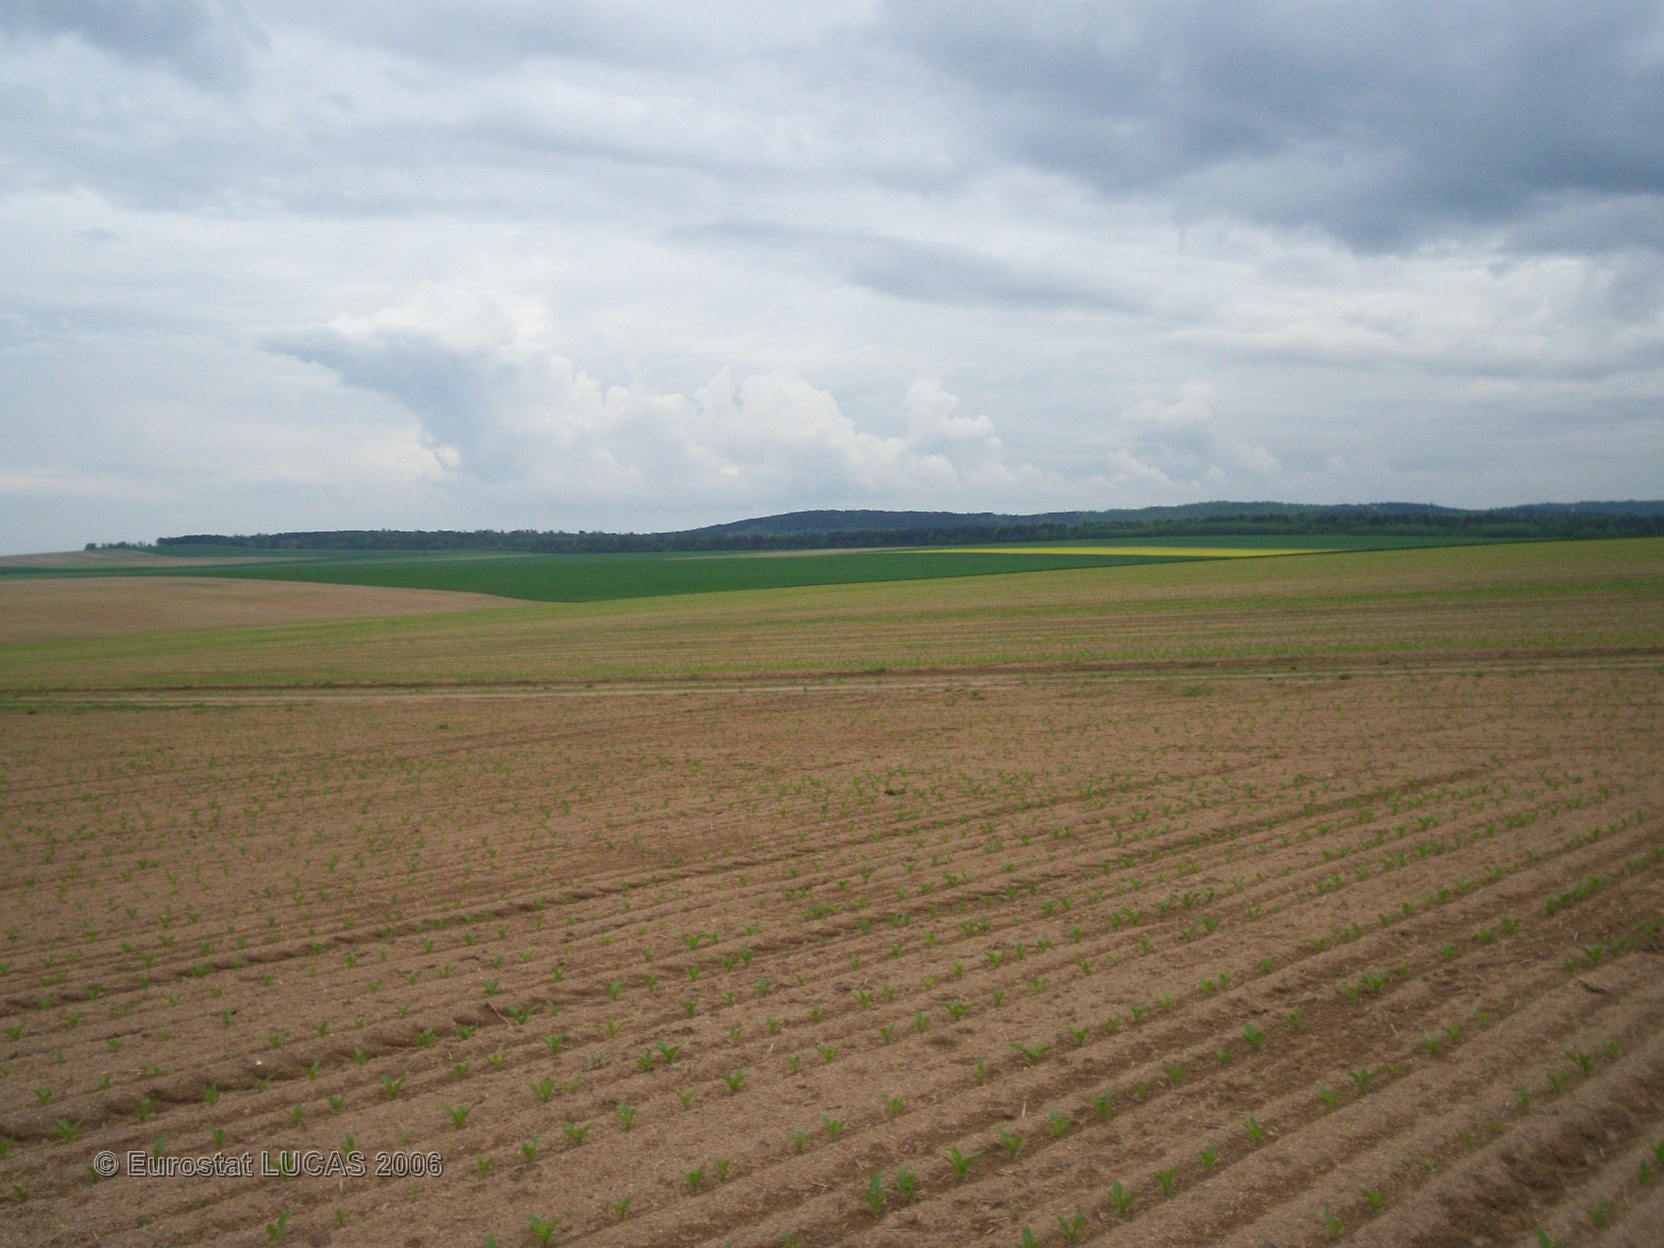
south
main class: Cropland
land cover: Sugar beet
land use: Agriculture (excluding fallow land and kitchen gardens)
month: May
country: FR
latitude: 49.2688
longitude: 4.3475
